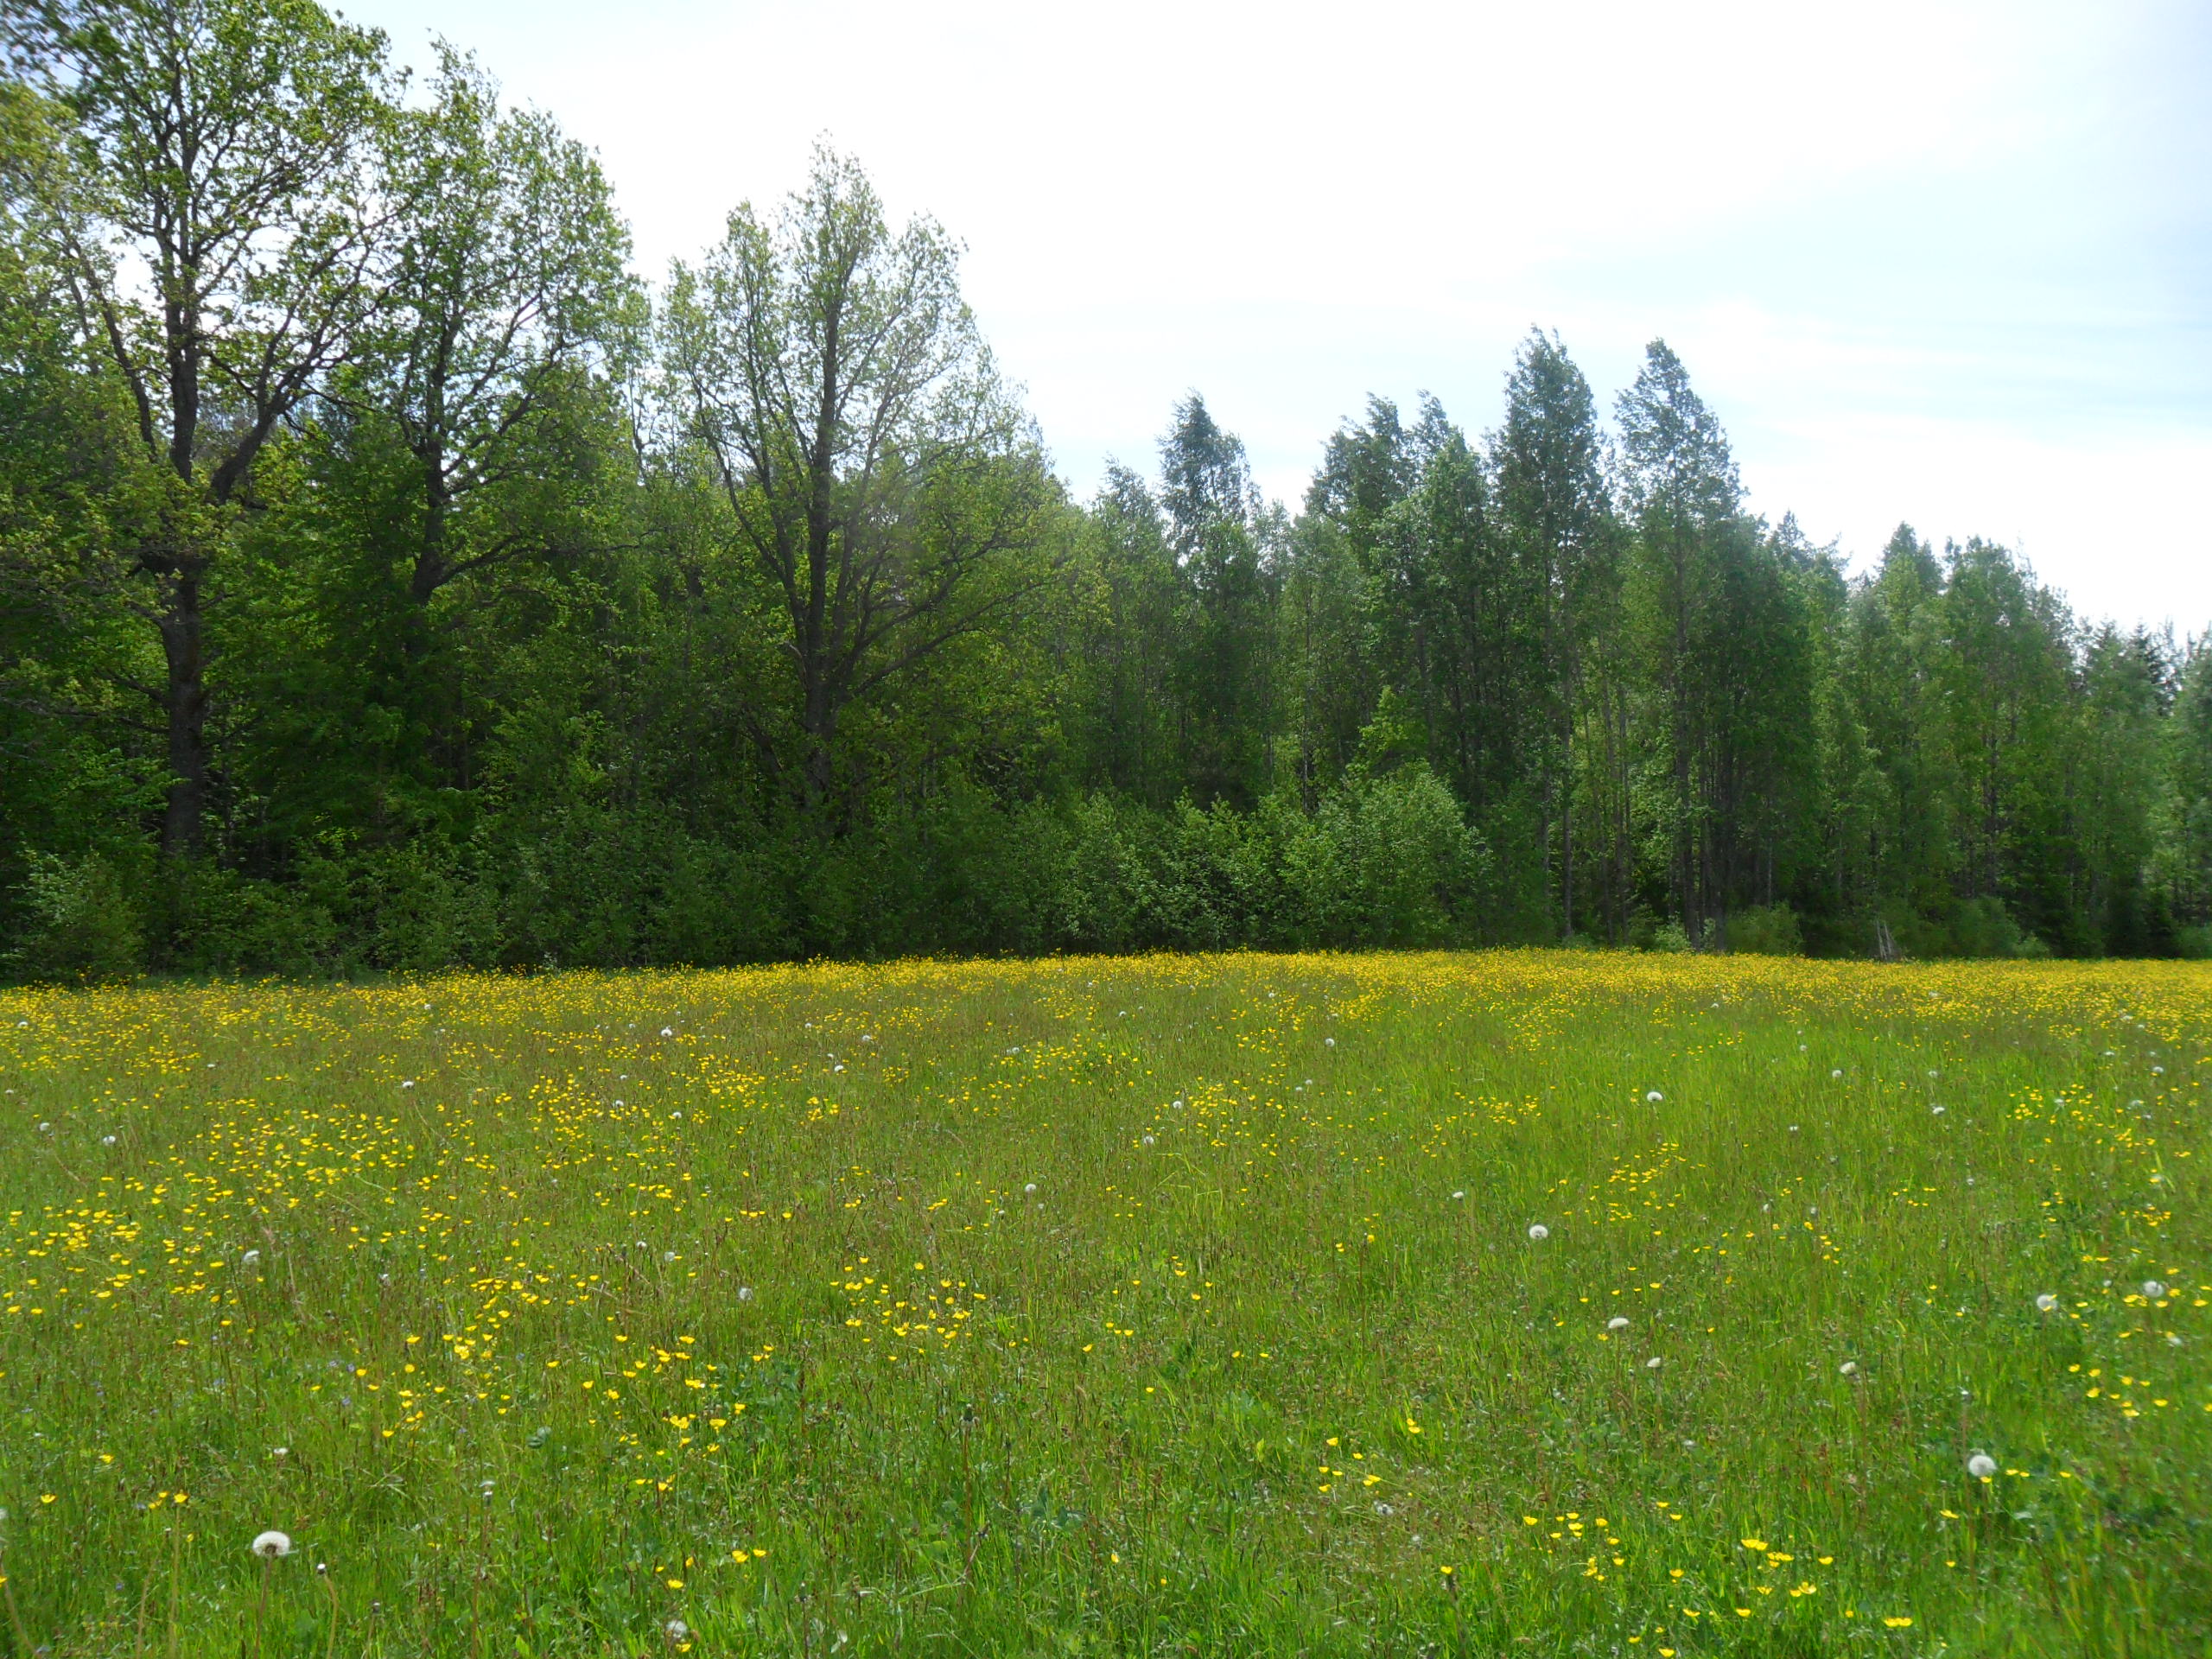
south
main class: Grassland
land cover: Grassland without tree/shrub cover
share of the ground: > 75 %
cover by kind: herbaceous plants 100 %
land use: Agriculture (excluding fallow land and kitchen gardens)
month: June
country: LV
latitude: 57.4007
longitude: 22.4508
